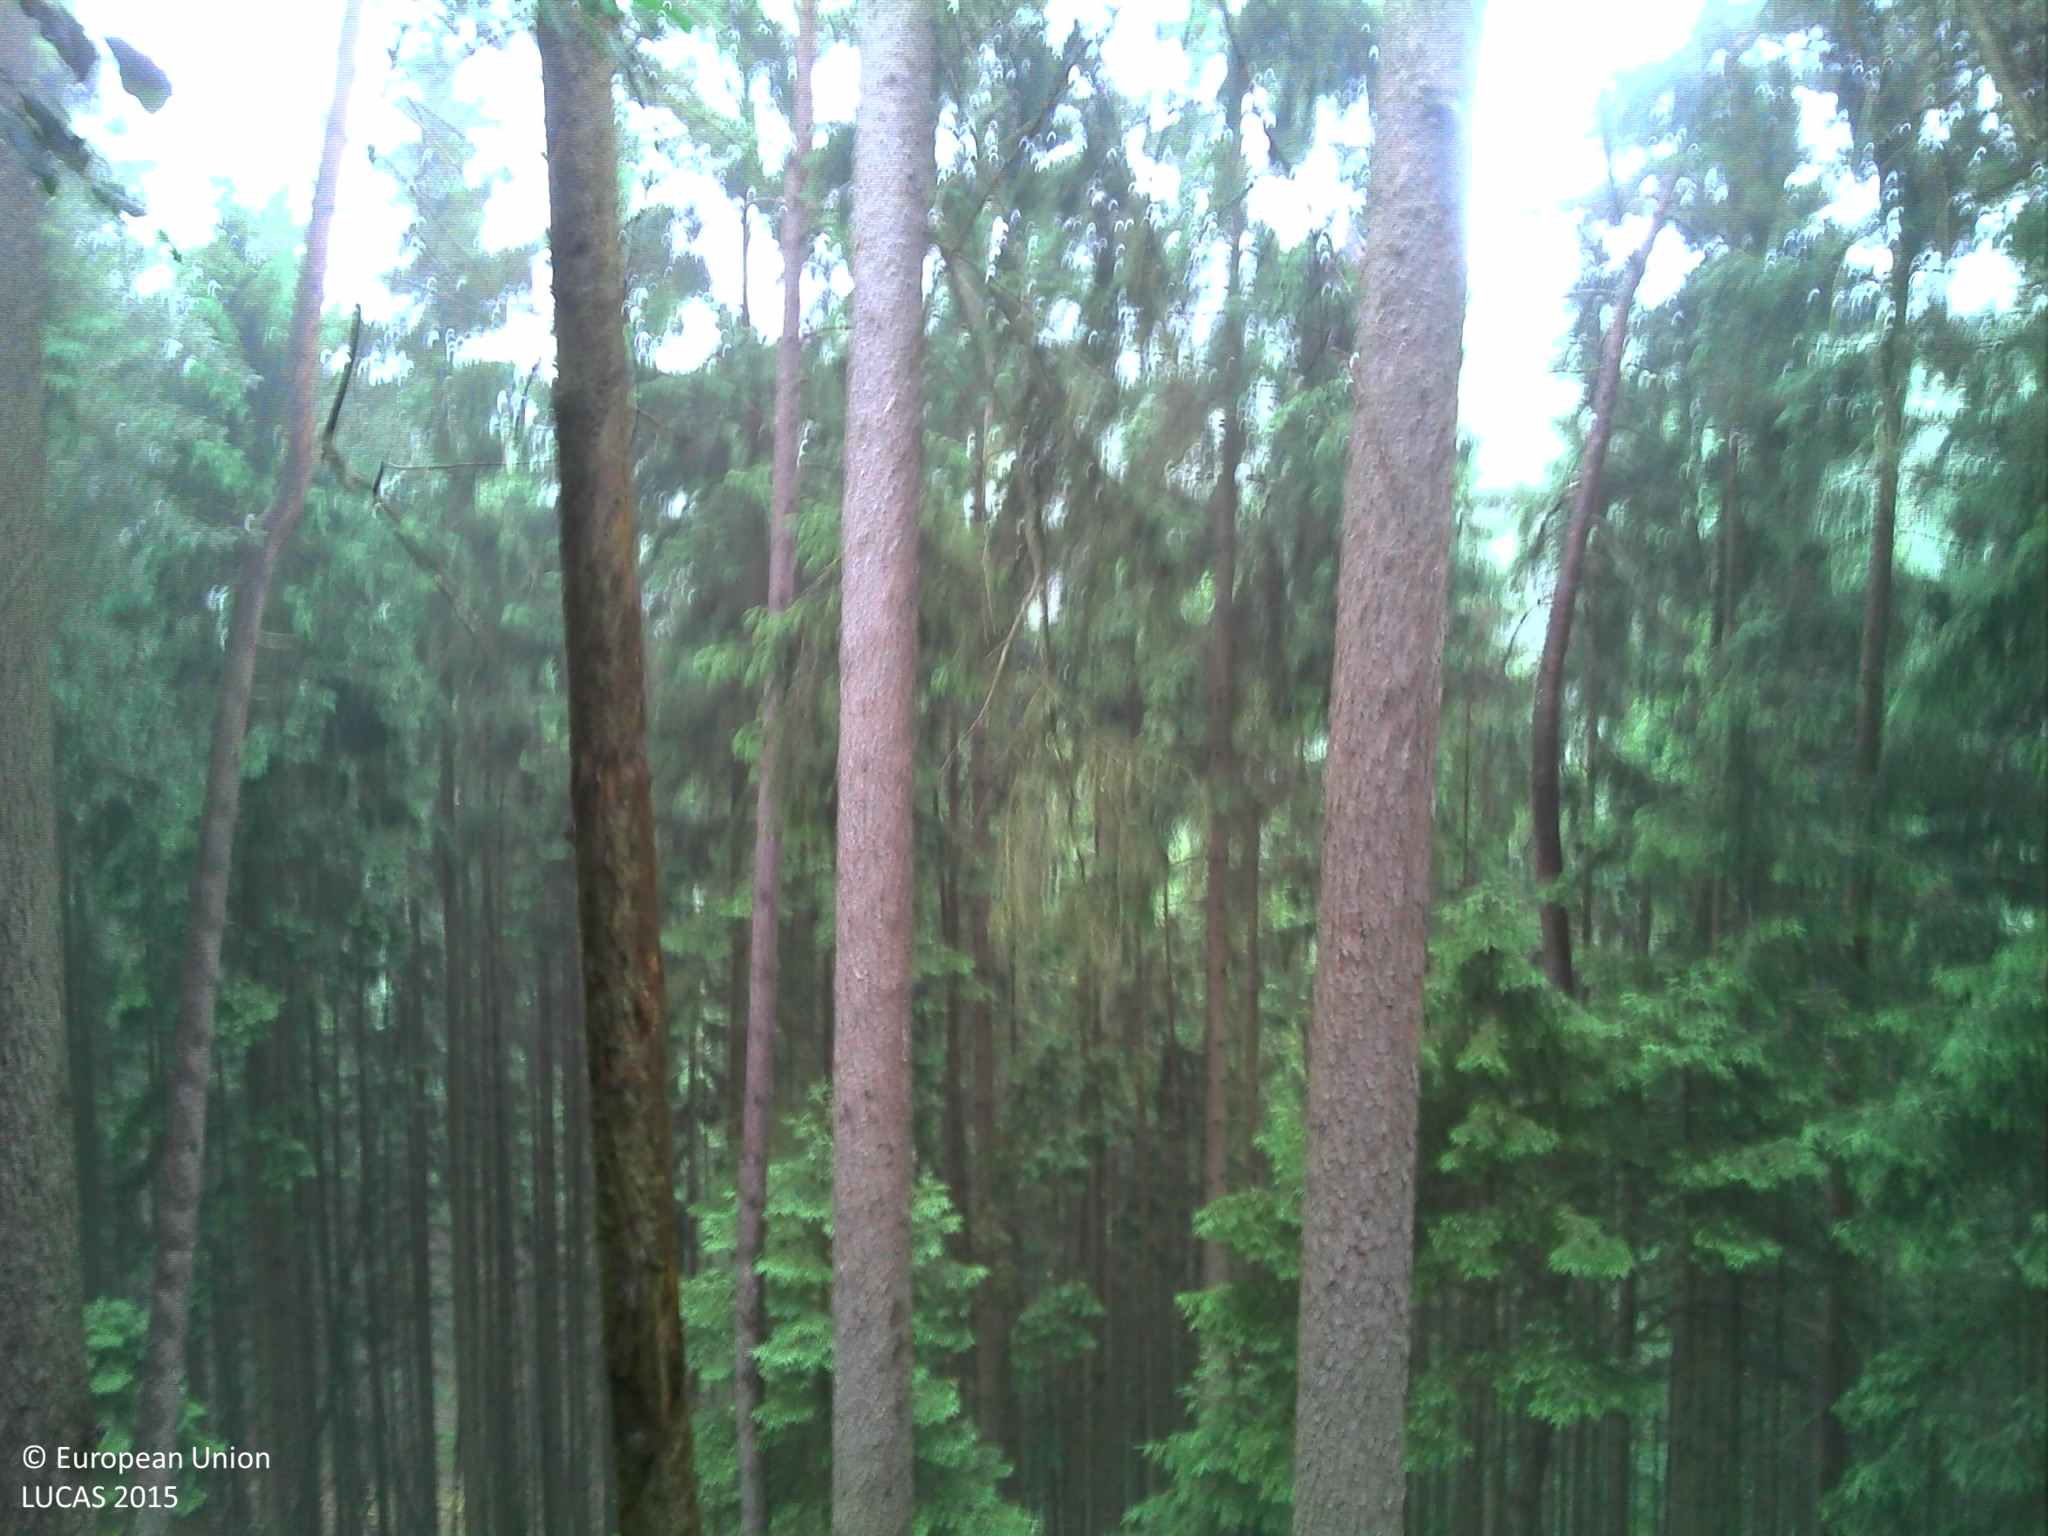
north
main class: Woodland
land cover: Spruce dominated mixed woodland
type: beech forest
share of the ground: > 75 %
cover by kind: coniferous forest trees 65 %, broadleaved forest trees 25 %, shrubs 5 %, herbaceous plants 5 %
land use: Forestry
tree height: > 5 m
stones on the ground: < 10 %
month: June
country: FR
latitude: 48.9919
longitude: 7.7183
